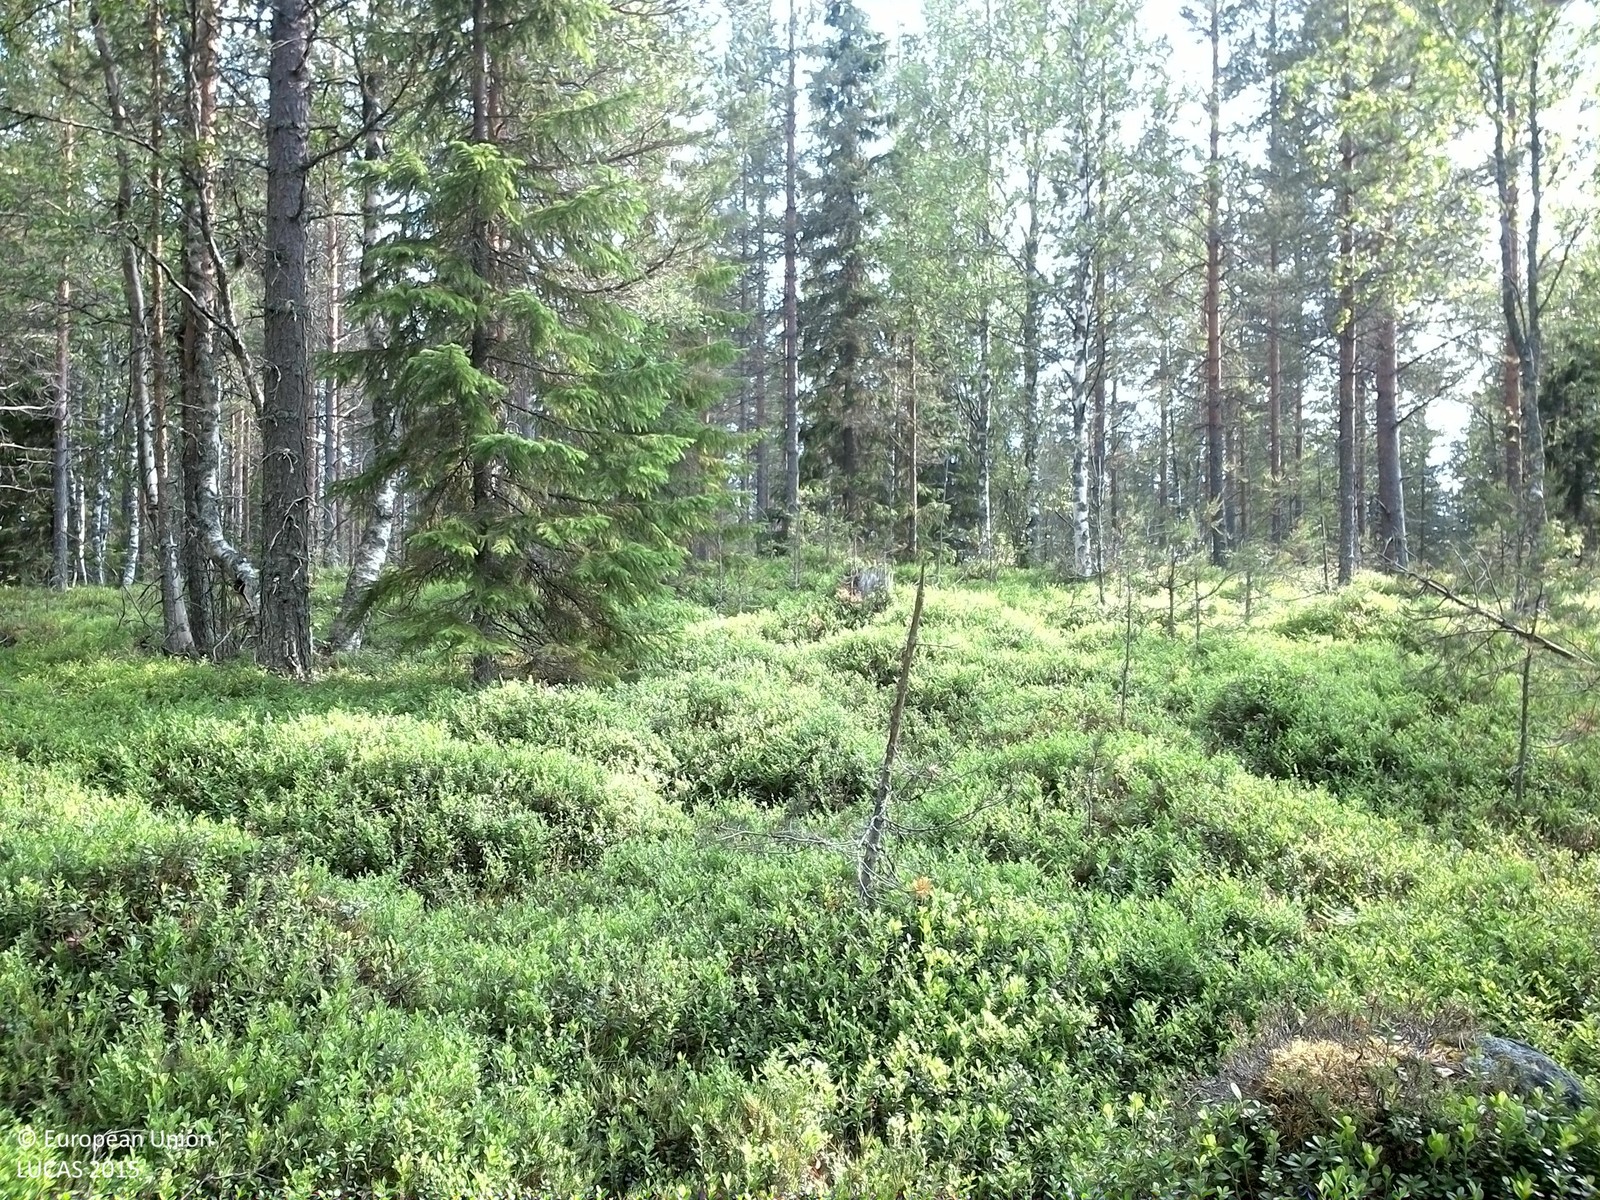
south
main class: Woodland
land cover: Pine dominated mixed woodland
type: boreal forest
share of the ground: 50 - 75 %
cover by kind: coniferous forest trees 45 %, shrubs 30 %, broadleaved forest trees 15 %, lichens and mosses 10 %
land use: Forestry
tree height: > 5 m
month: July
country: SE
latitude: 63.5401
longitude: 17.3159
